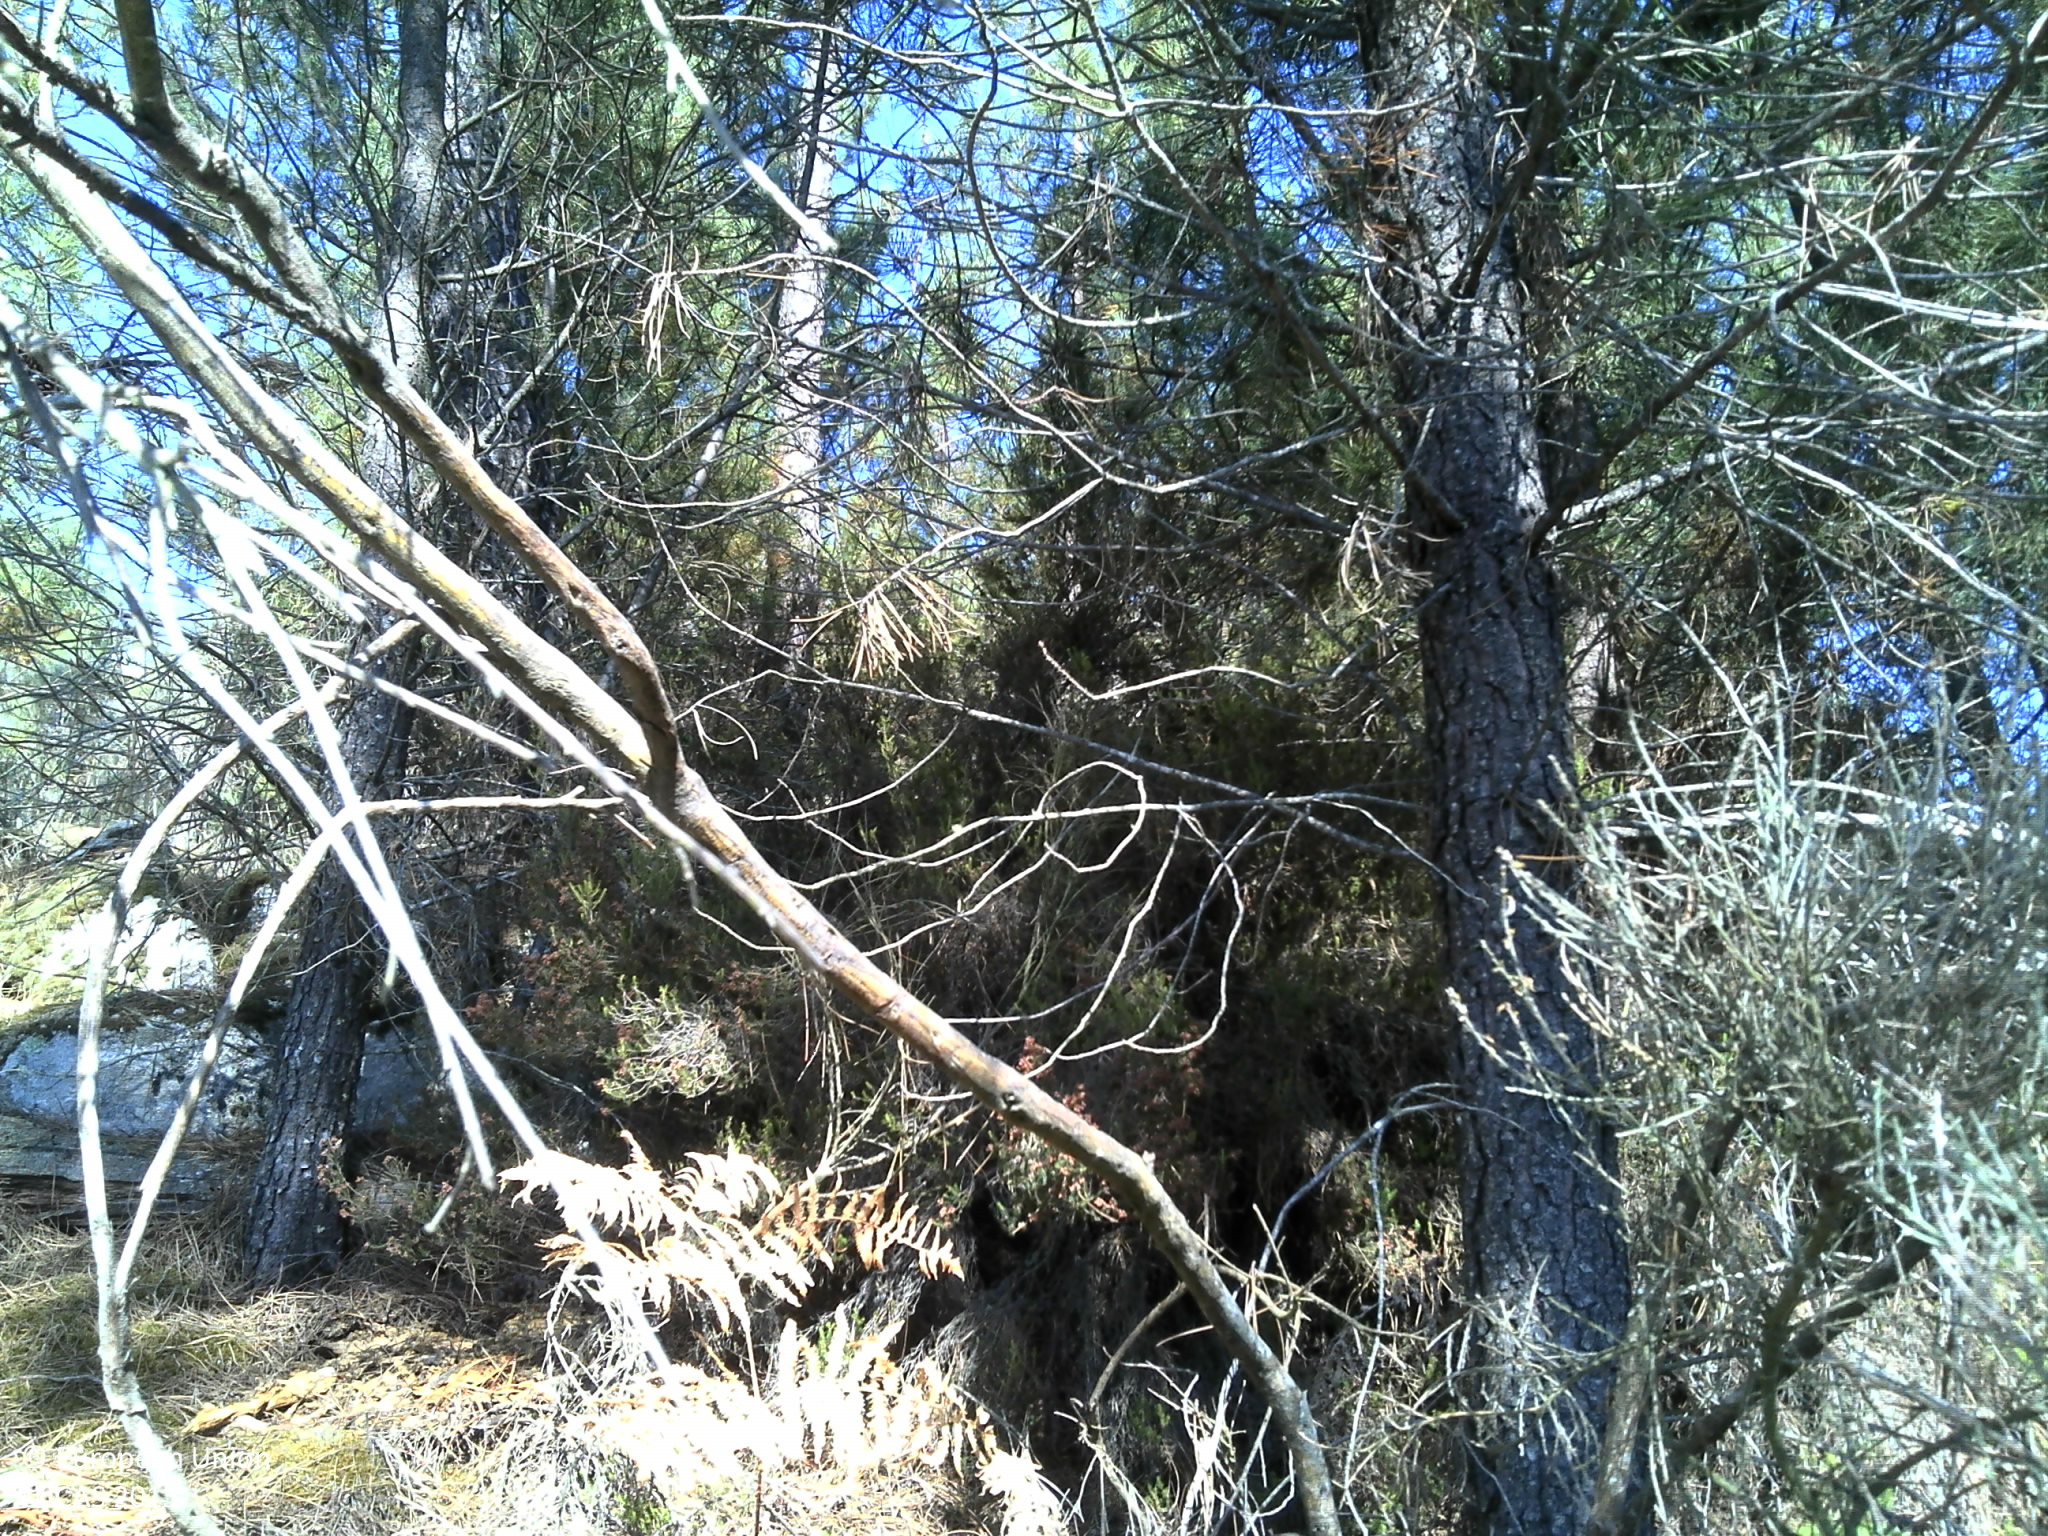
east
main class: Woodland
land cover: Pine dominated coniferous woodland
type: coniferous forest of the mediterranean region
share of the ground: 10 - 25 %
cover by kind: shrubs 80 %, coniferous forest trees 15 %, consolidated bare surface 5 %
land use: Forestry
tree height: > 5 m
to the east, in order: Pine dominated coniferous woodland; Rocks and stones; Pine dominated coniferous woodland; Rocks and stones; Pine dominated coniferous woodland; Shrubland with sparse tree cover; Rocks and stones; Shrubland with sparse tree cover
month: July
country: PT
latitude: 40.7753
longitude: -7.4484
